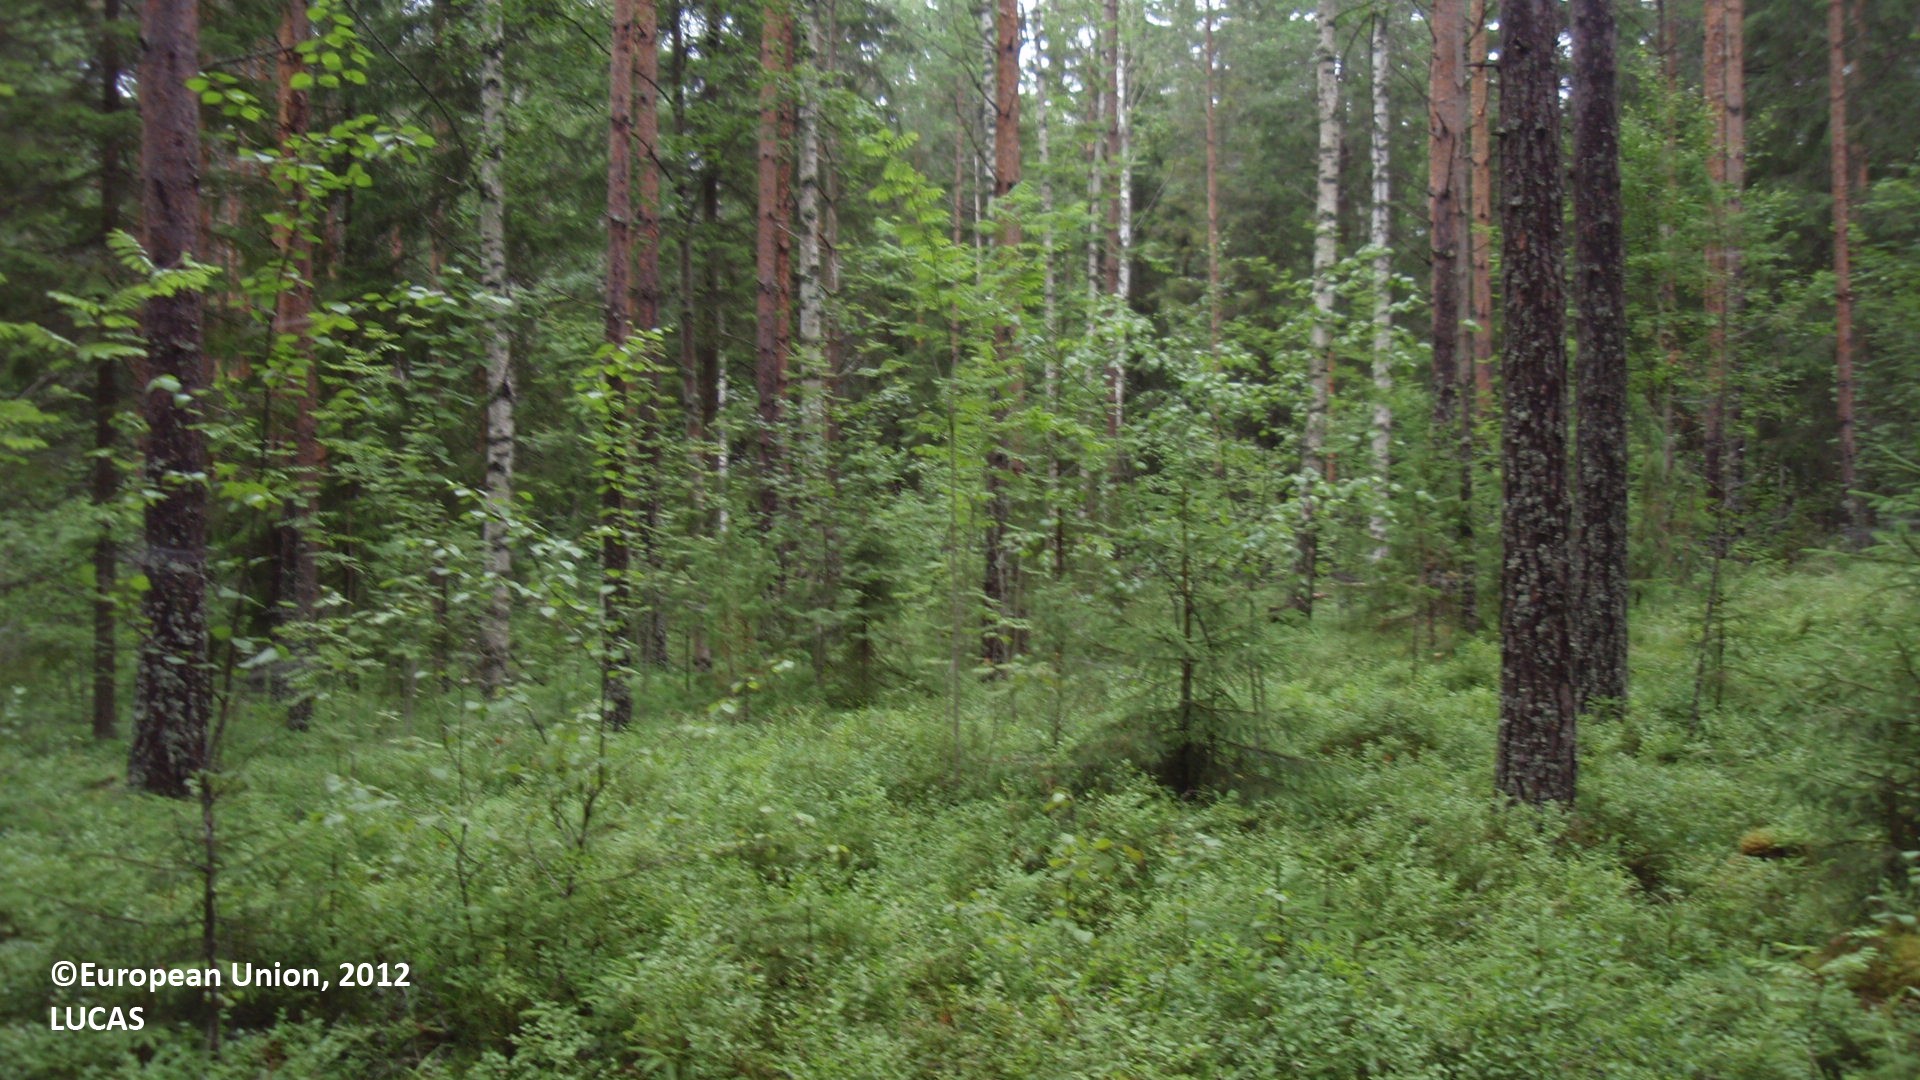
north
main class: Woodland
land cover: Pine dominated coniferous woodland
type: boreal forest
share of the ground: 25 - 50 %
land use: Forestry
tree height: > 5 m
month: July
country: FI
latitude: 61.5199
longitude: 27.3354
